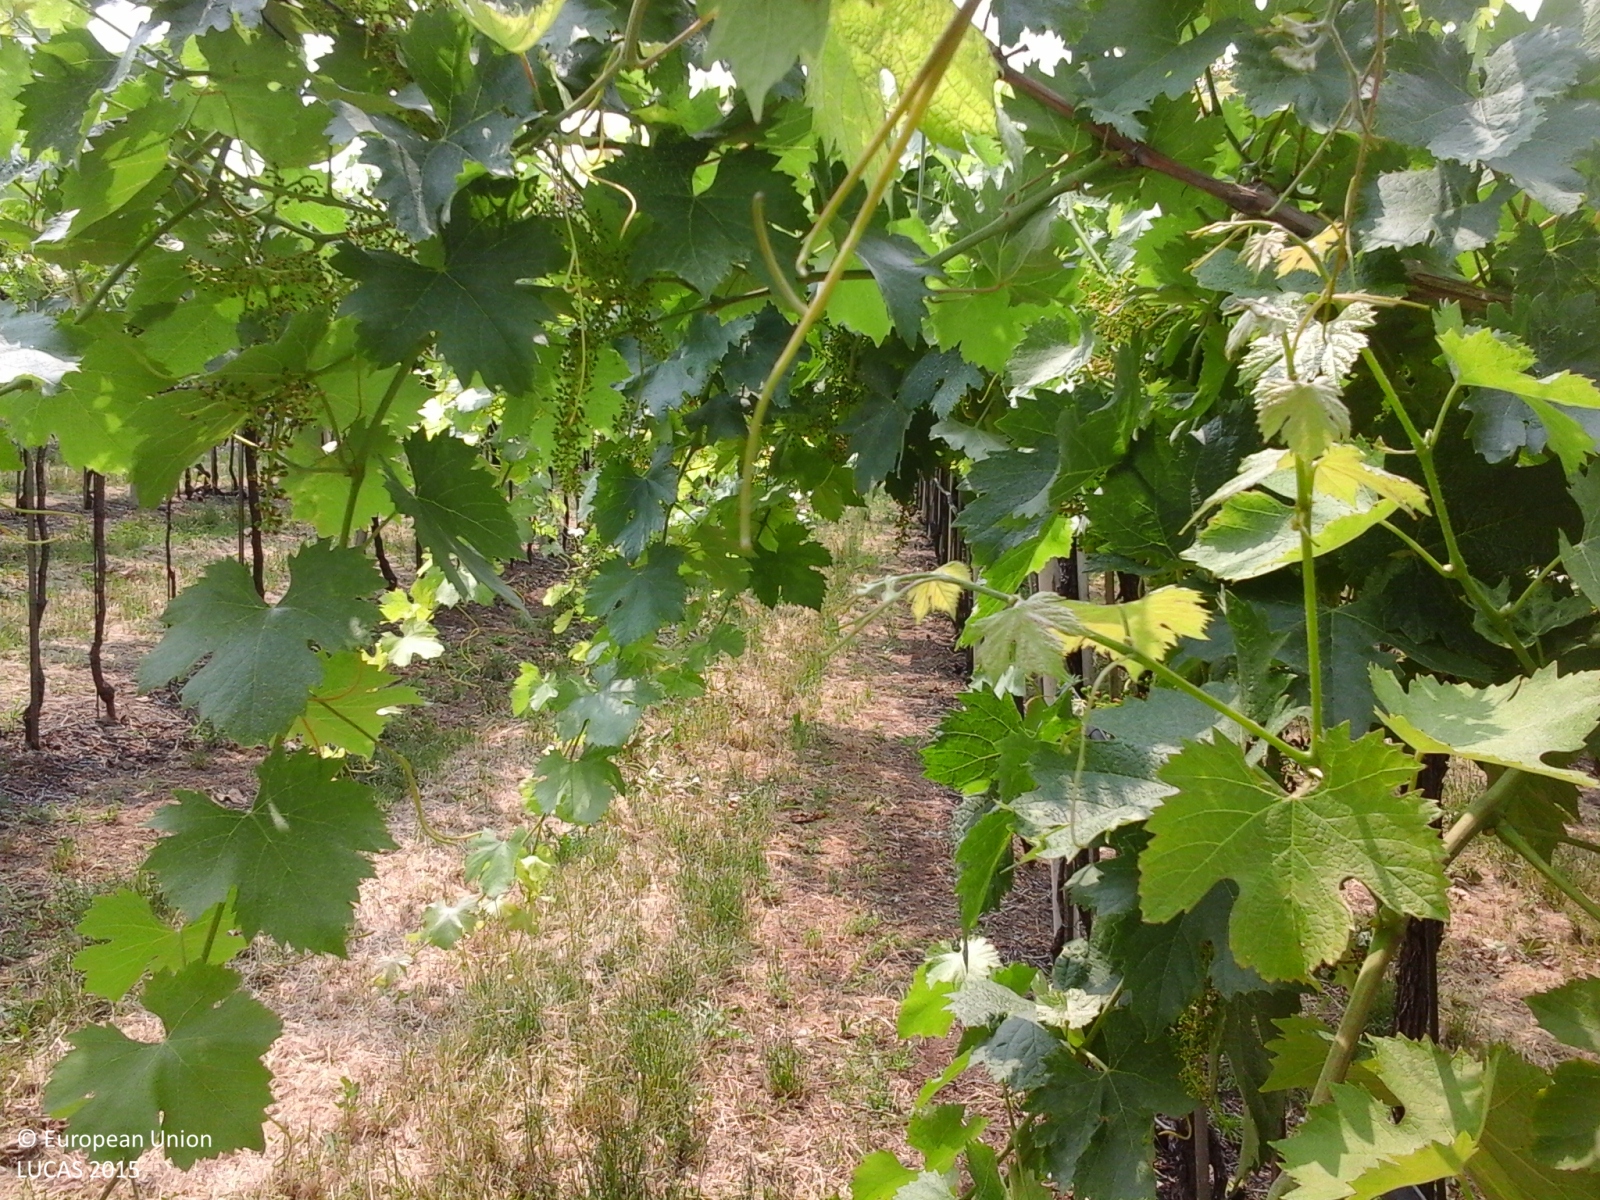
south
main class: Cropland
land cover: Vineyards
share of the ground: 50 - 75 %
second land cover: Grassland without tree/shrub cover
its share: > 75 %
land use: Agriculture (excluding fallow land and kitchen gardens)
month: June
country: IT
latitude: 45.4256
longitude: 11.1866
